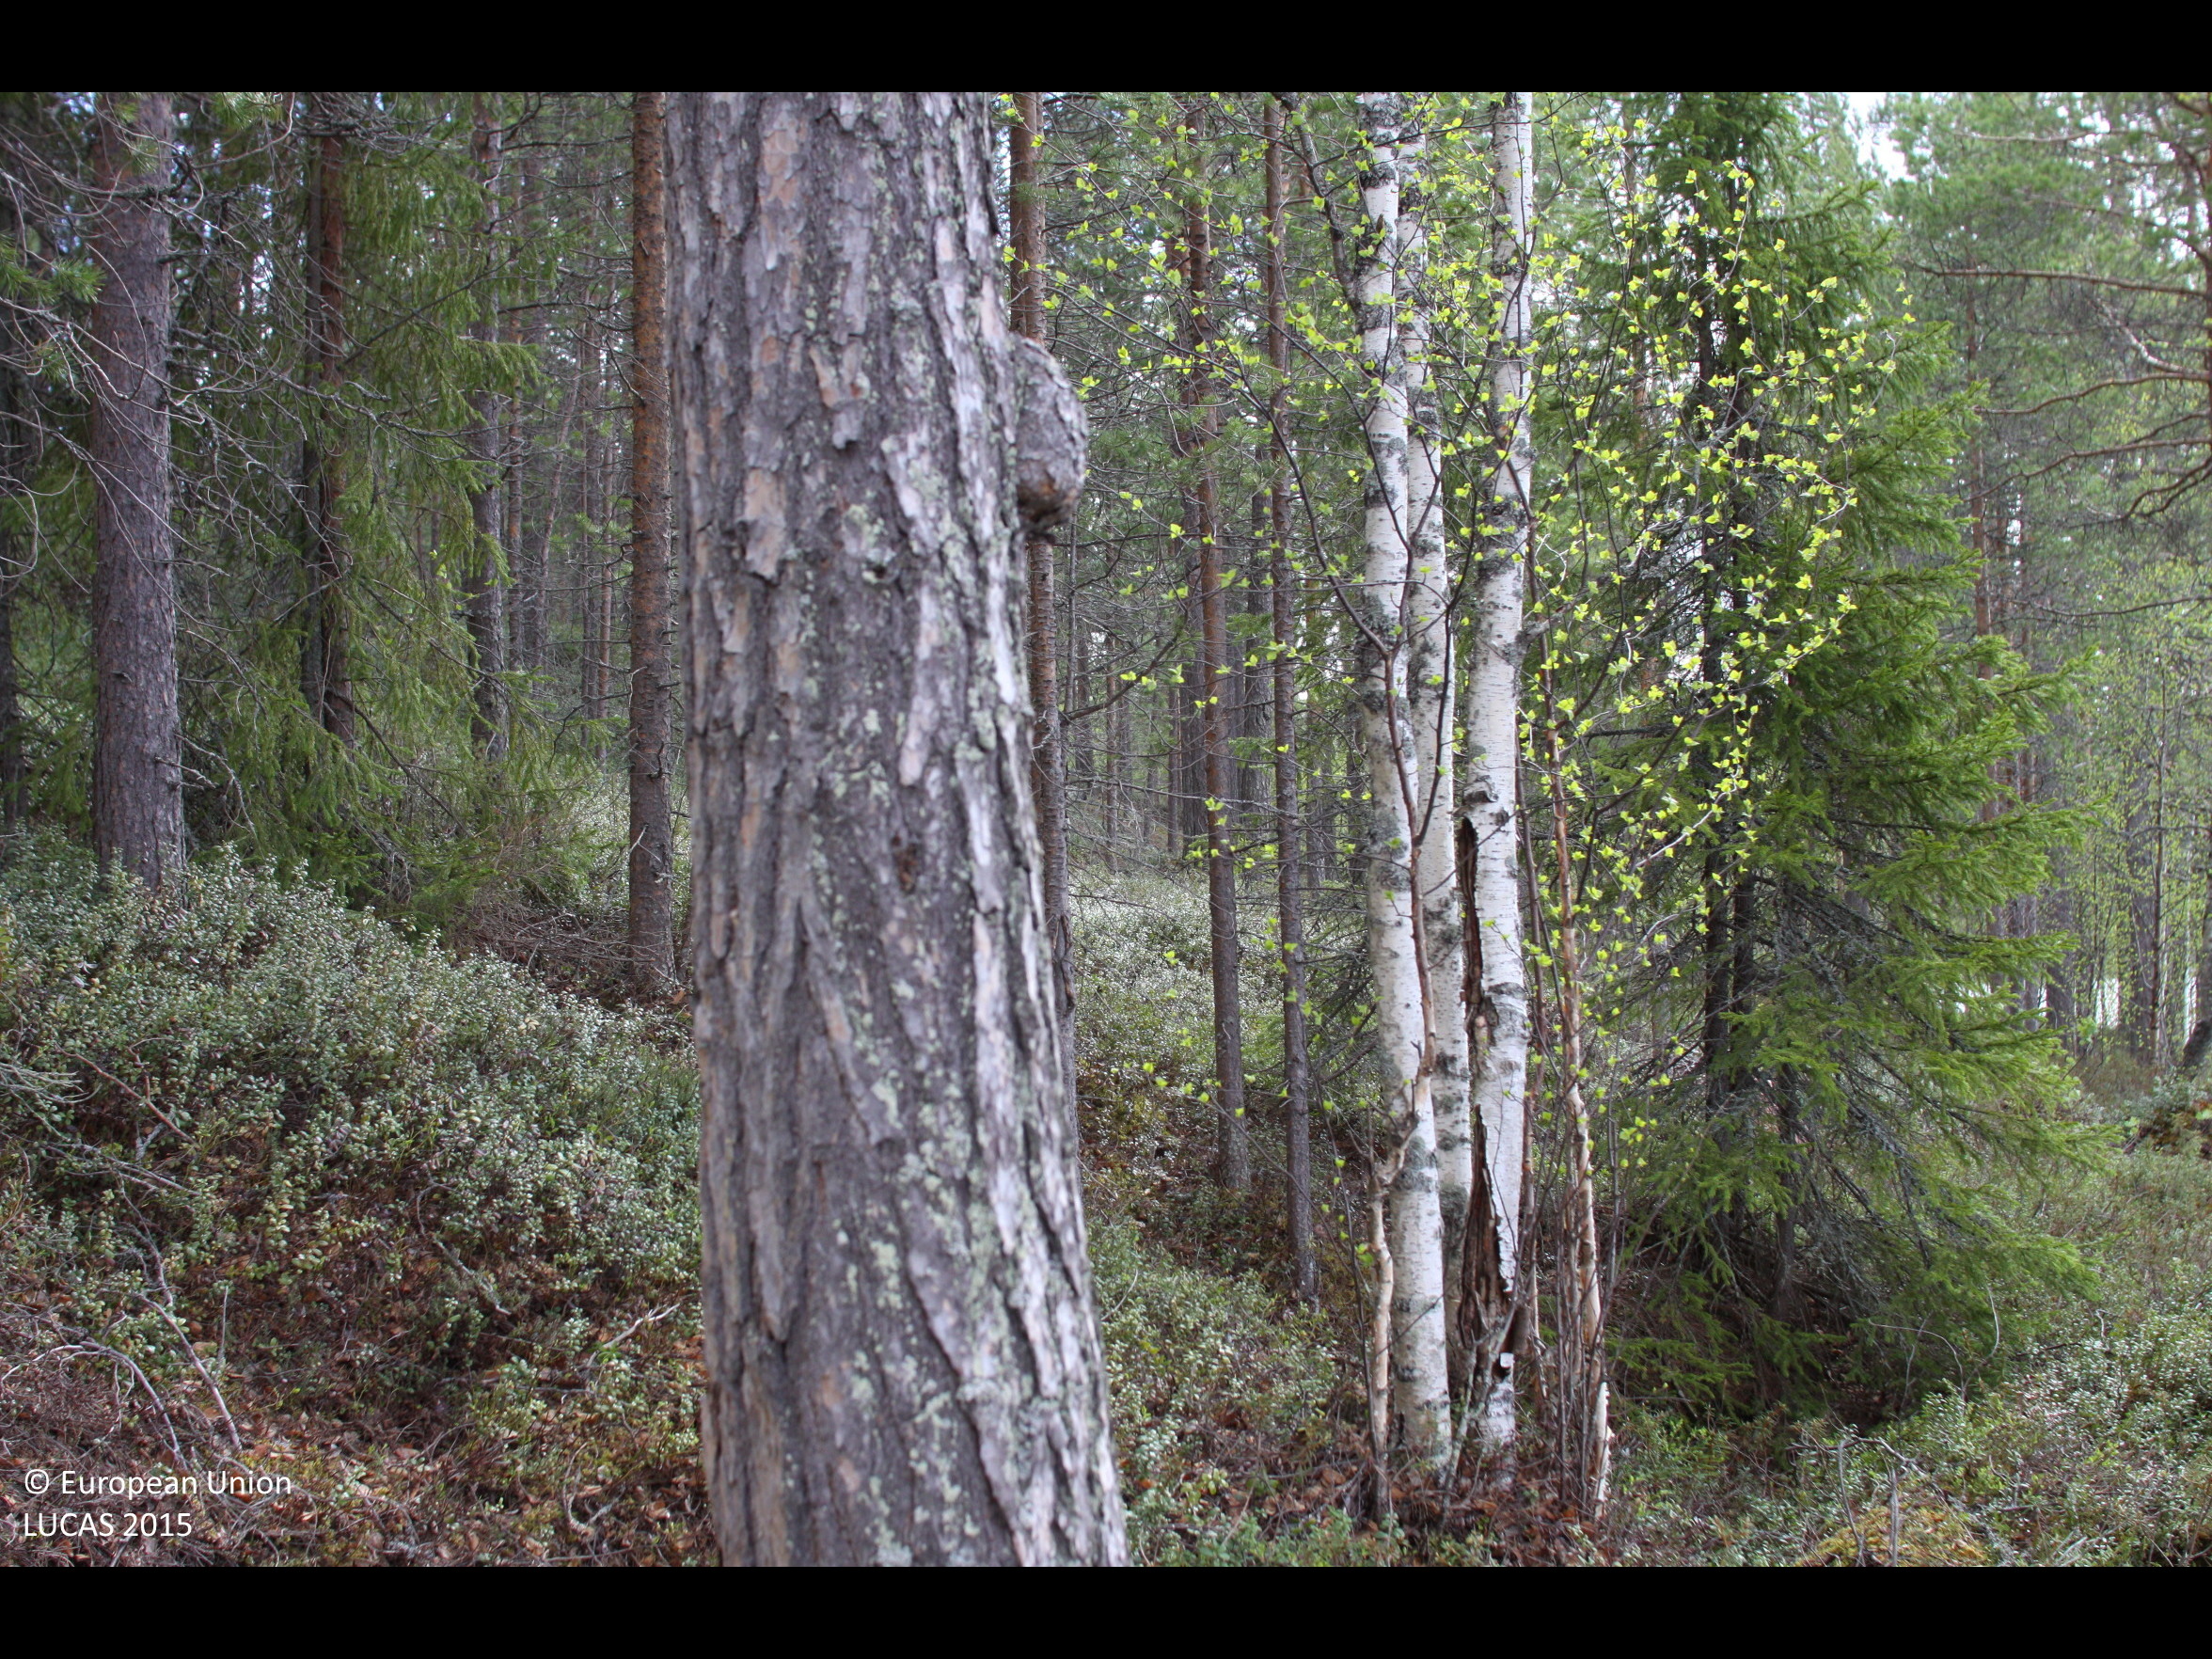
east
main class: Woodland
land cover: Pine dominated coniferous woodland
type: boreal forest
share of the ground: > 75 %
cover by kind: coniferous forest trees 90 %, broadleaved forest trees 5 %, shrubs 5 %
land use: Amenities, museums, leisure
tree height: > 5 m
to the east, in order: Pine dominated coniferous woodland; Pine dominated mixed woodland; Pine dominated coniferous woodland; Ditches and canals; Artificial constructions in urban areas
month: June
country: FI
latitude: 66.1207
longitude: 28.1380
